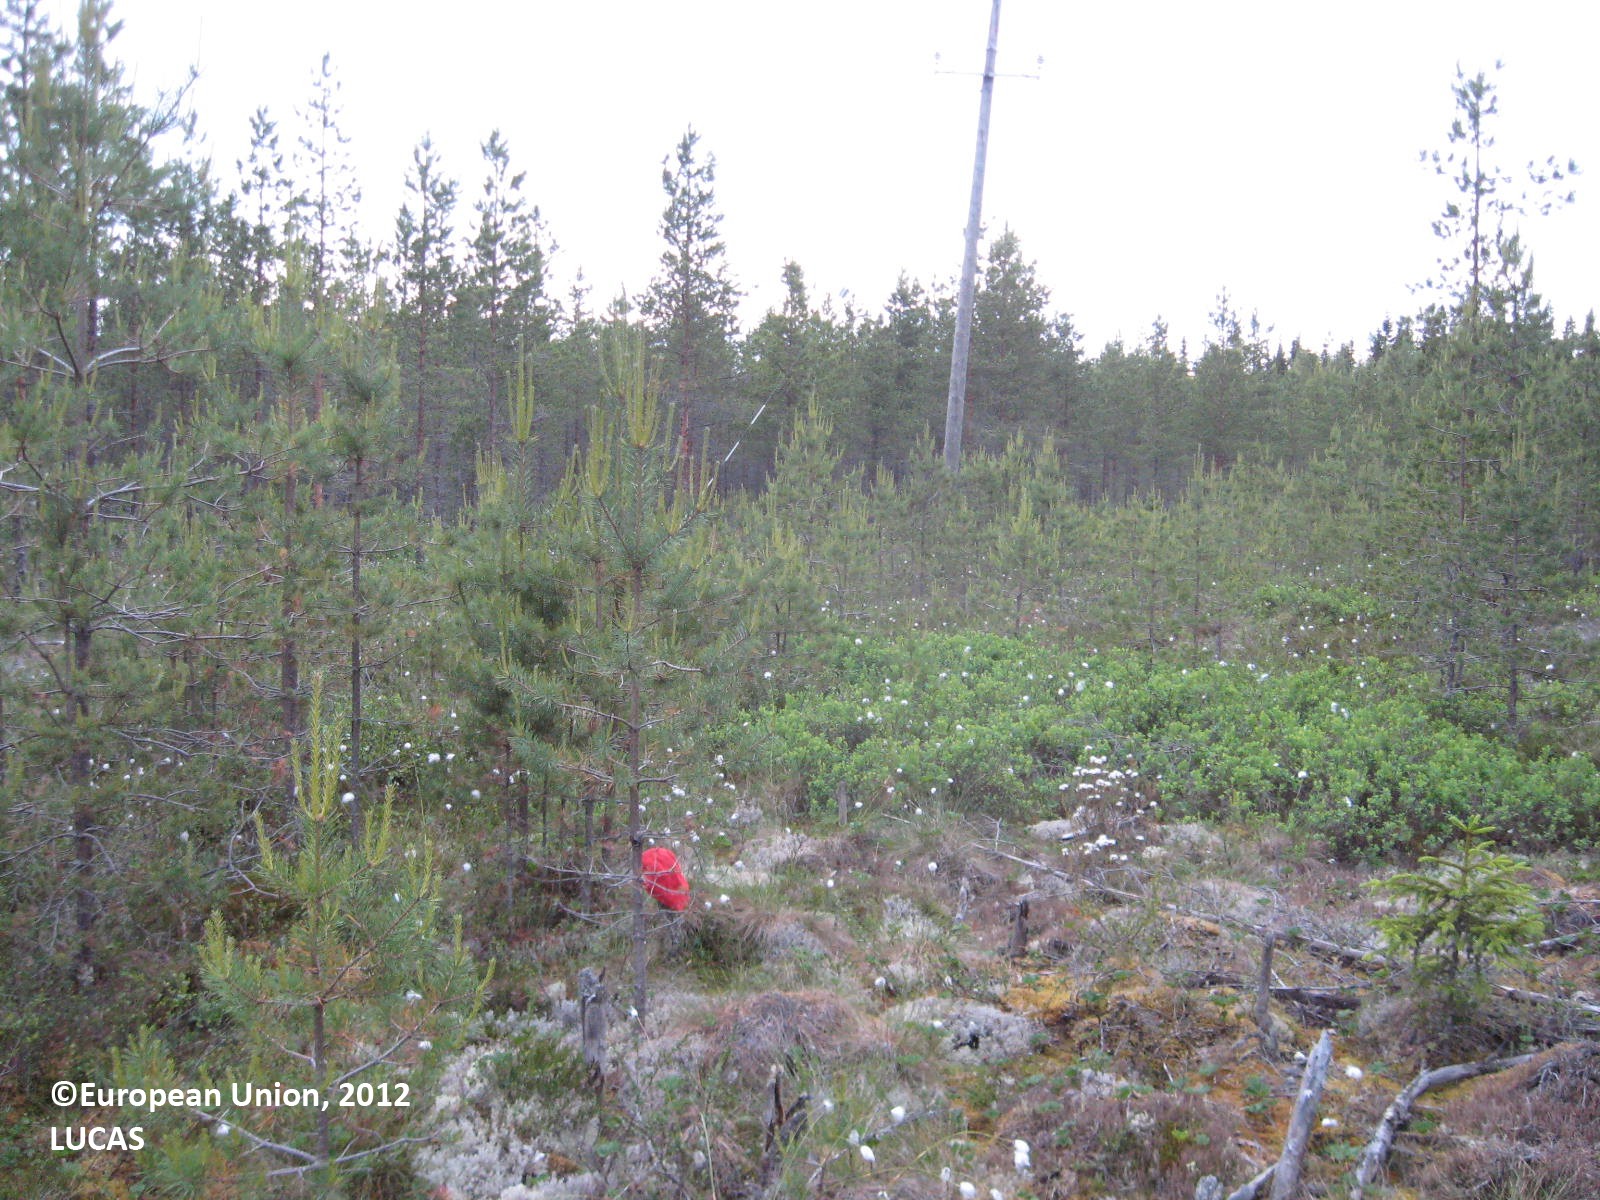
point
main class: Woodland
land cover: Pine dominated coniferous woodland
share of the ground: > 75 %
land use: Forestry
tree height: < 5 m
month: June
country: FI
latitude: 62.8987
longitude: 22.6668
